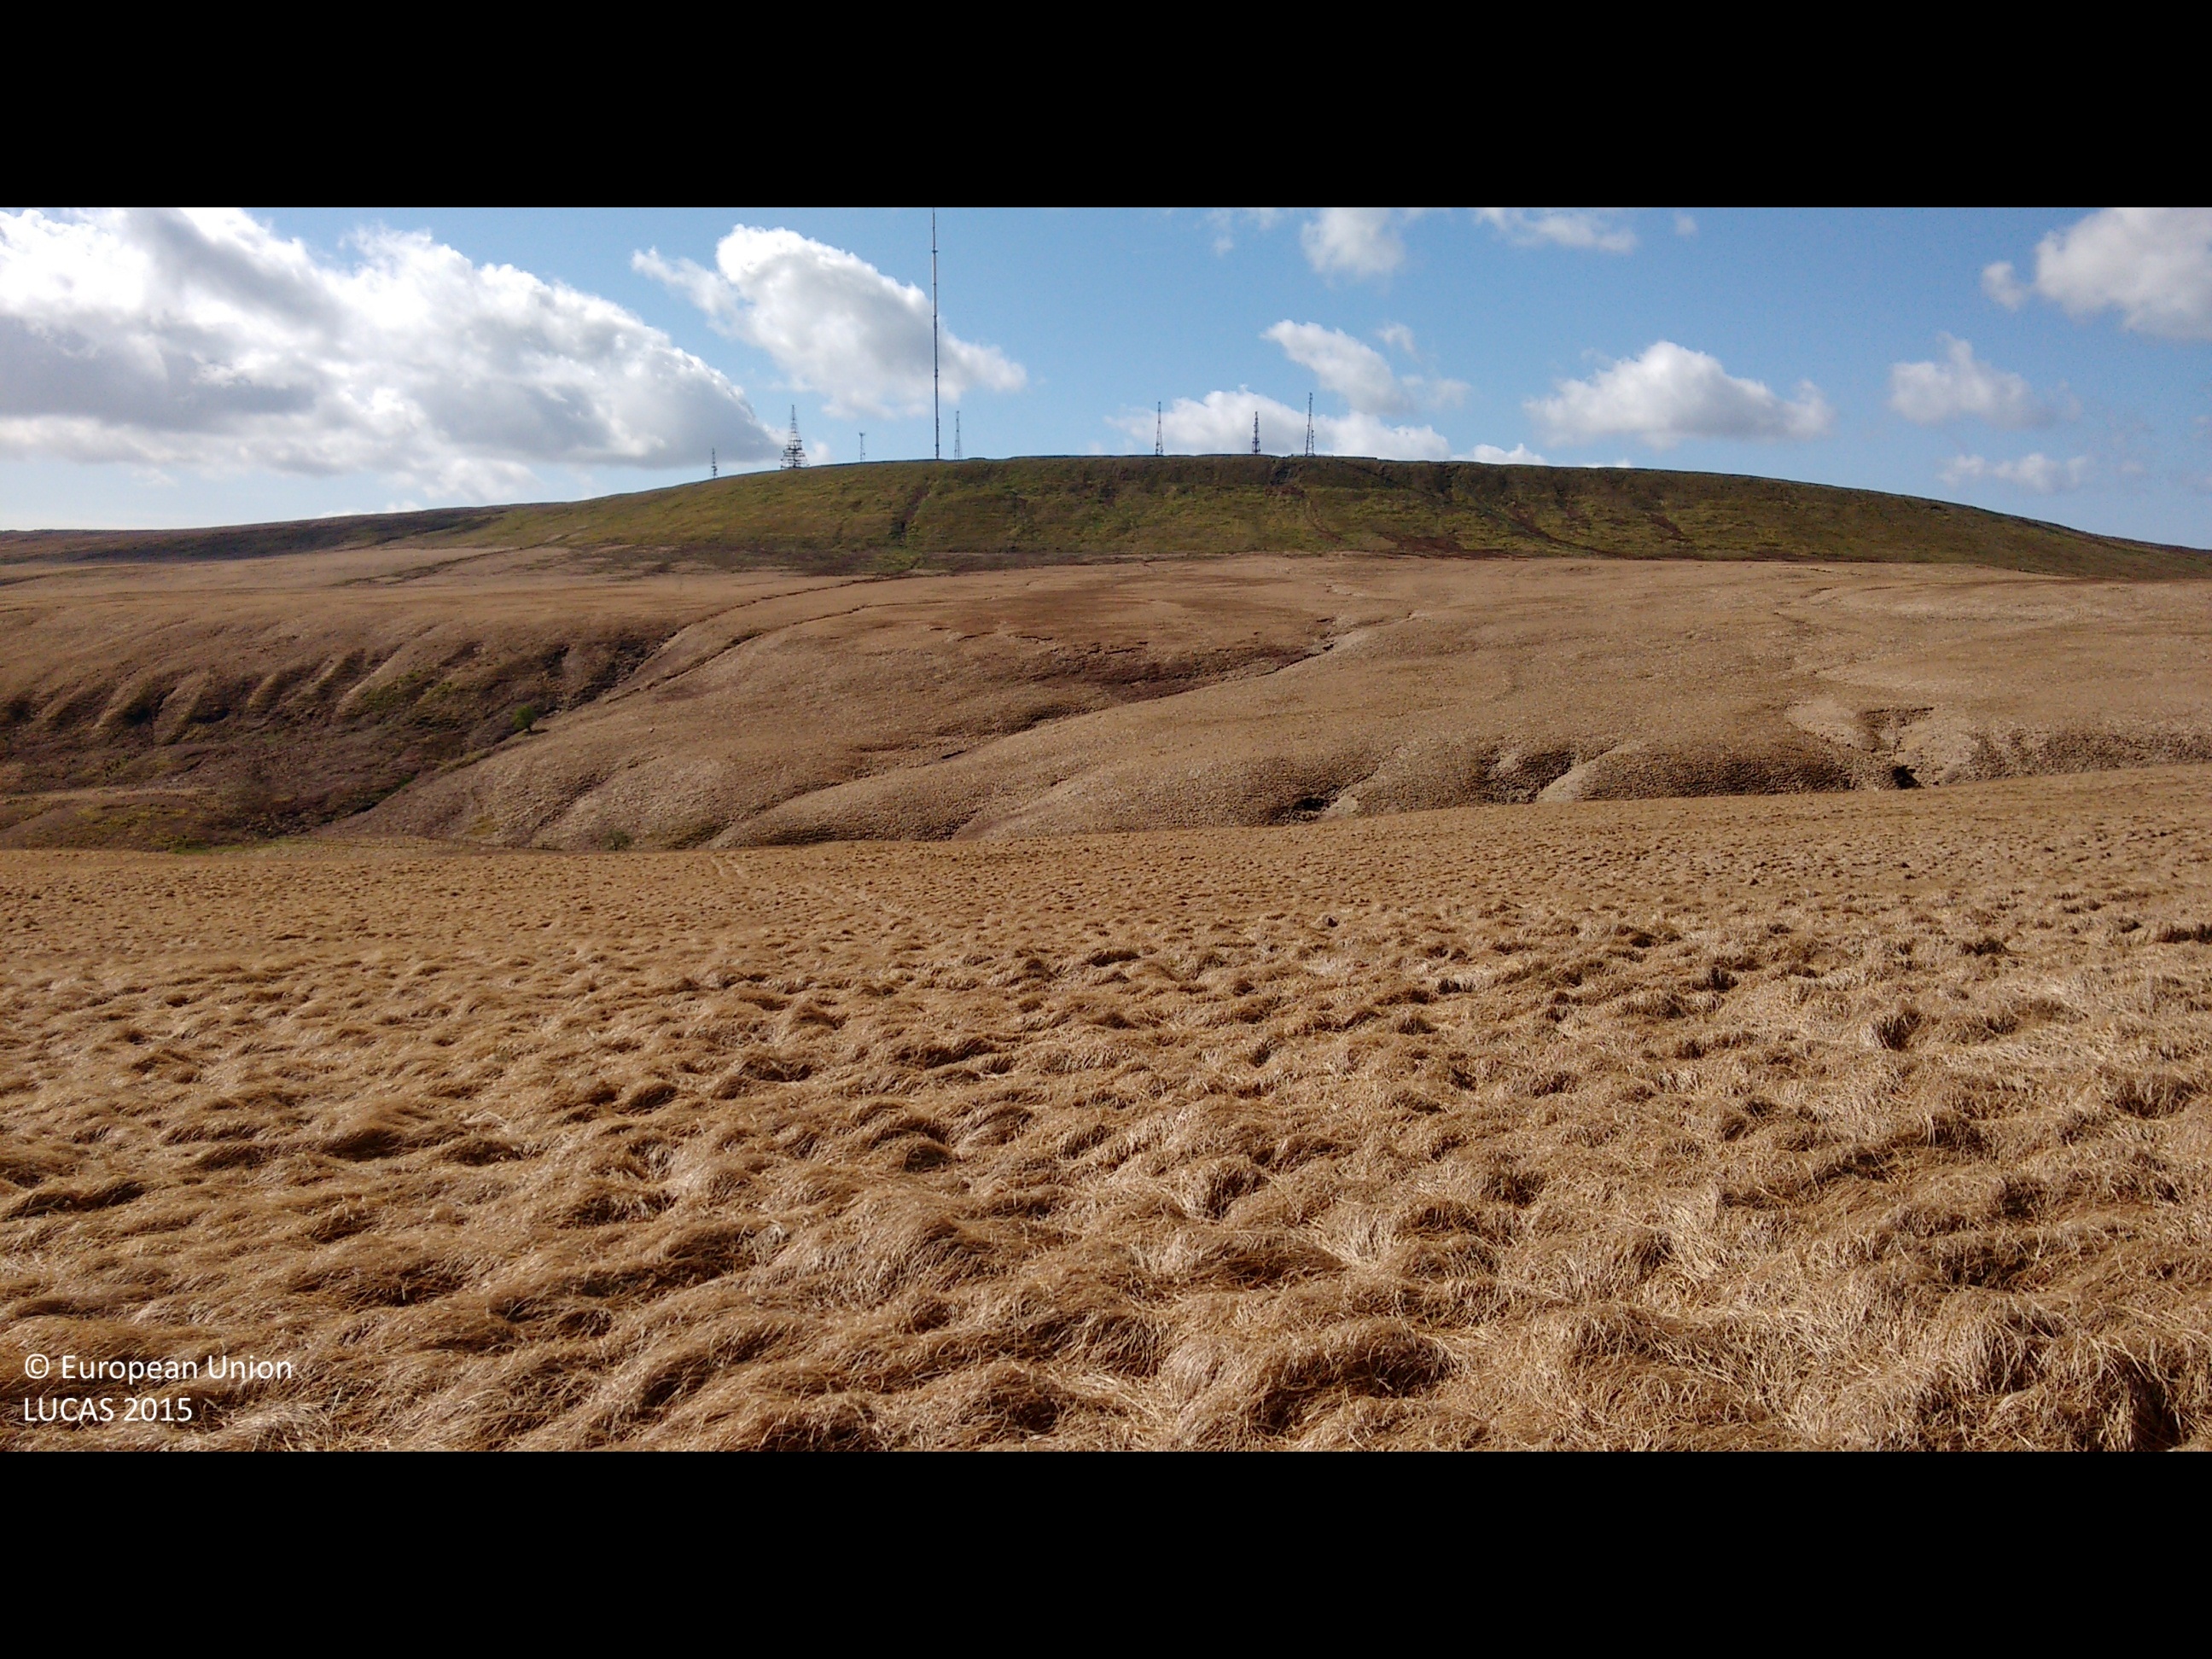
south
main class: Grassland
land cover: Grassland without tree/shrub cover
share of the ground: > 75 %
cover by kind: herbaceous plants 100 %
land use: Agriculture (excluding fallow land and kitchen gardens)
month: May
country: GB
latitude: 53.6416
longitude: -2.5142
